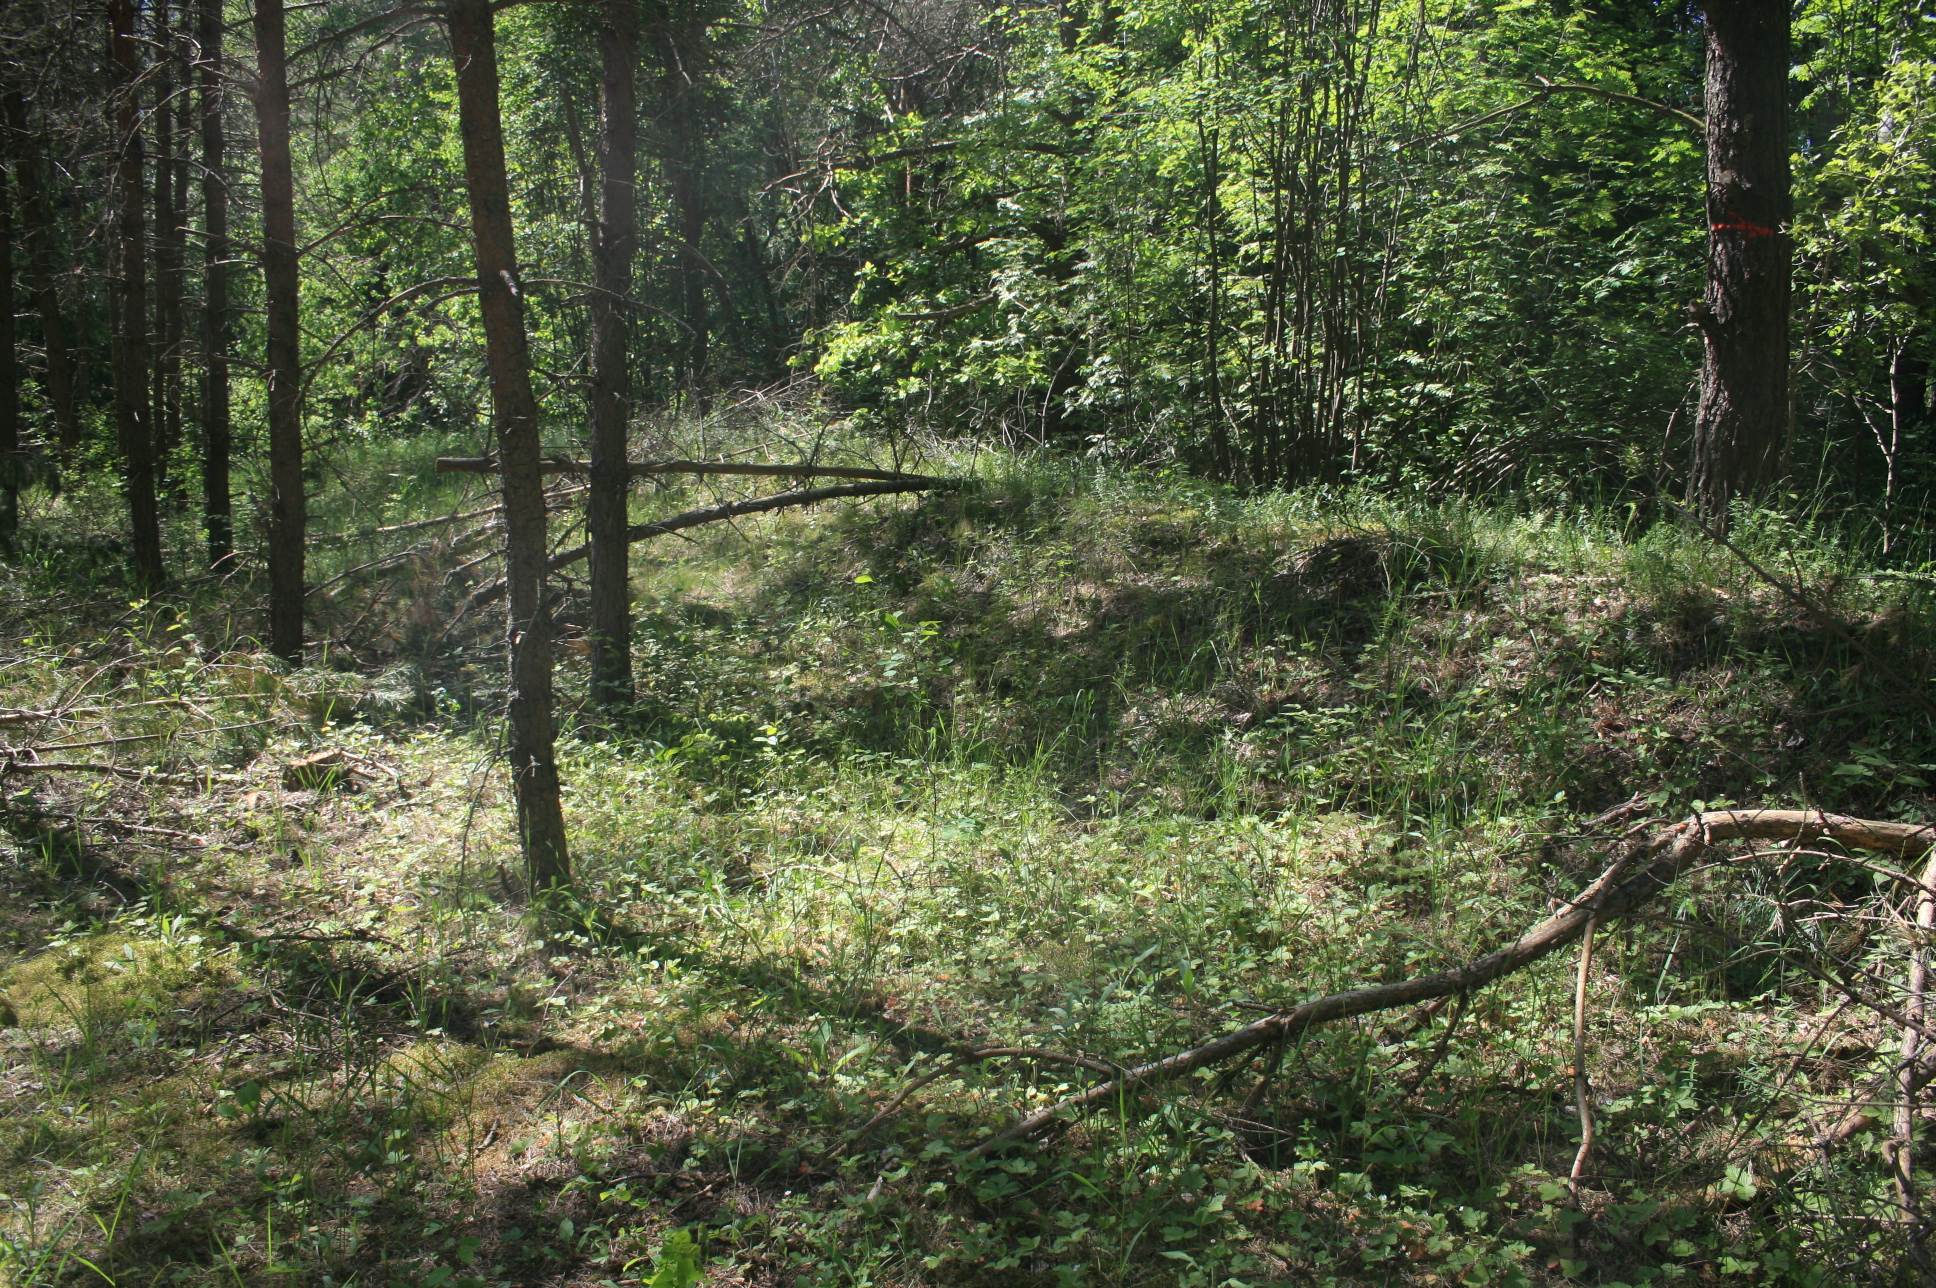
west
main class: Woodland
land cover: Pine dominated coniferous woodland
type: hemiboreal forest and nemoral coniferous forest and mixed broadleaved-coniferous forest
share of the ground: > 75 %
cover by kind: coniferous forest trees 85 %, broadleaved forest trees 5 %, herbaceous plants 5 %, lichens and mosses 5 %
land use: Forestry
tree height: > 5 m
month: June
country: LT
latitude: 55.5118
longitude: 22.2019
